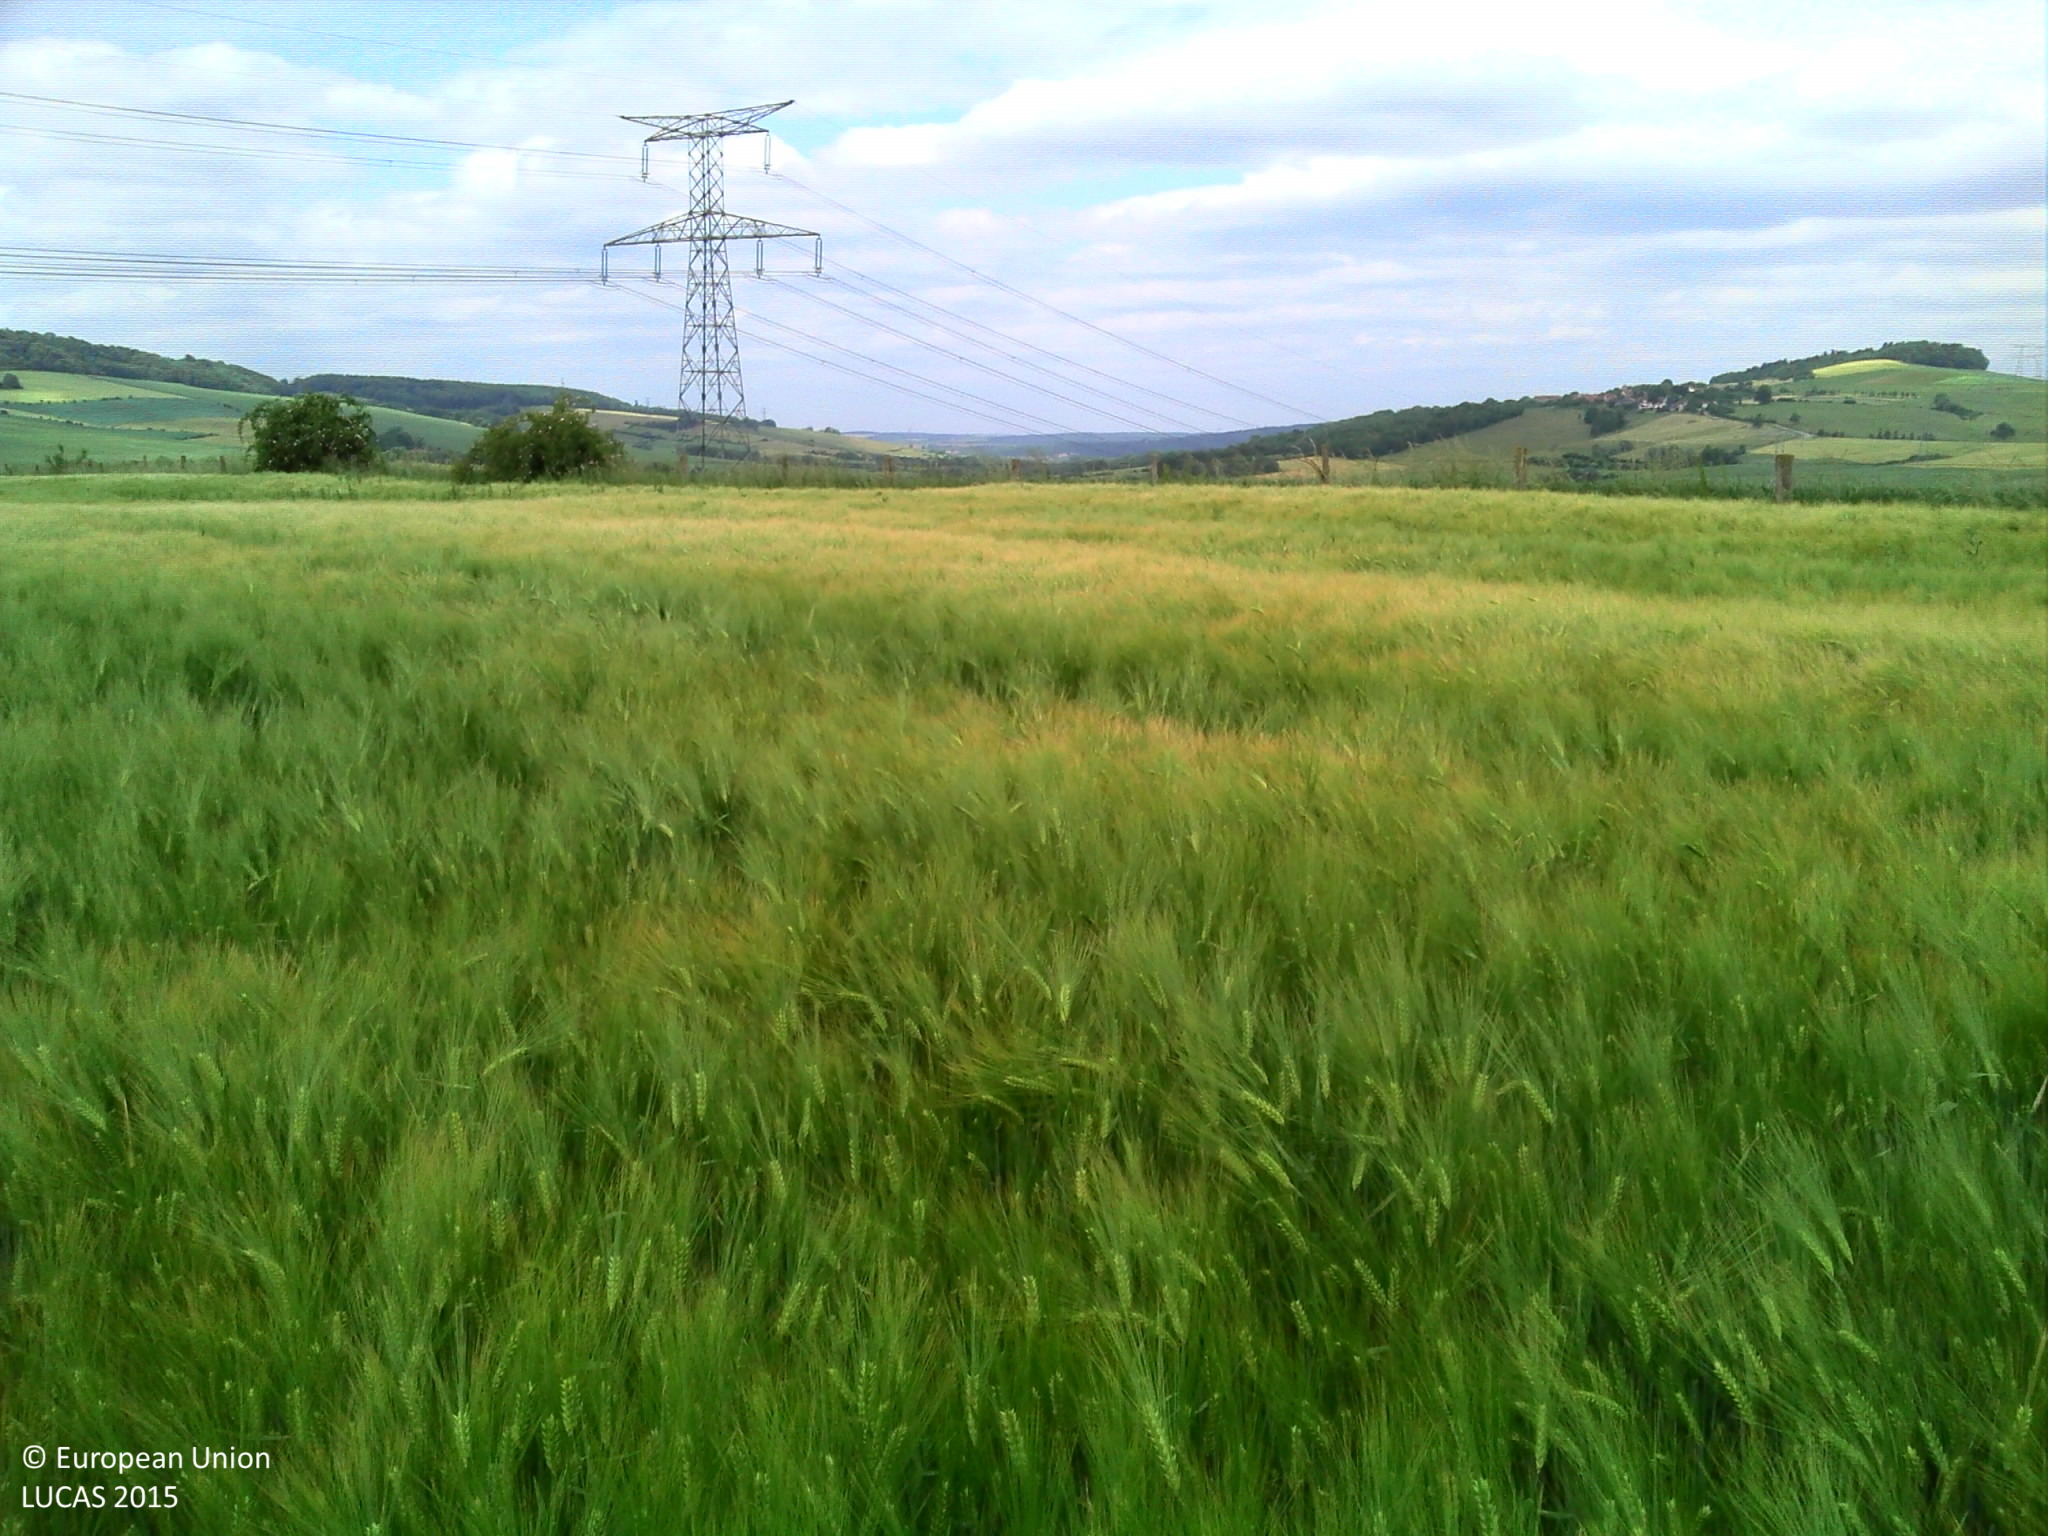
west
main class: Cropland
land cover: Barley
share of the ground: > 75 %
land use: Agriculture (excluding fallow land and kitchen gardens)
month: June
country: FR
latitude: 48.8415
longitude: 6.1711
